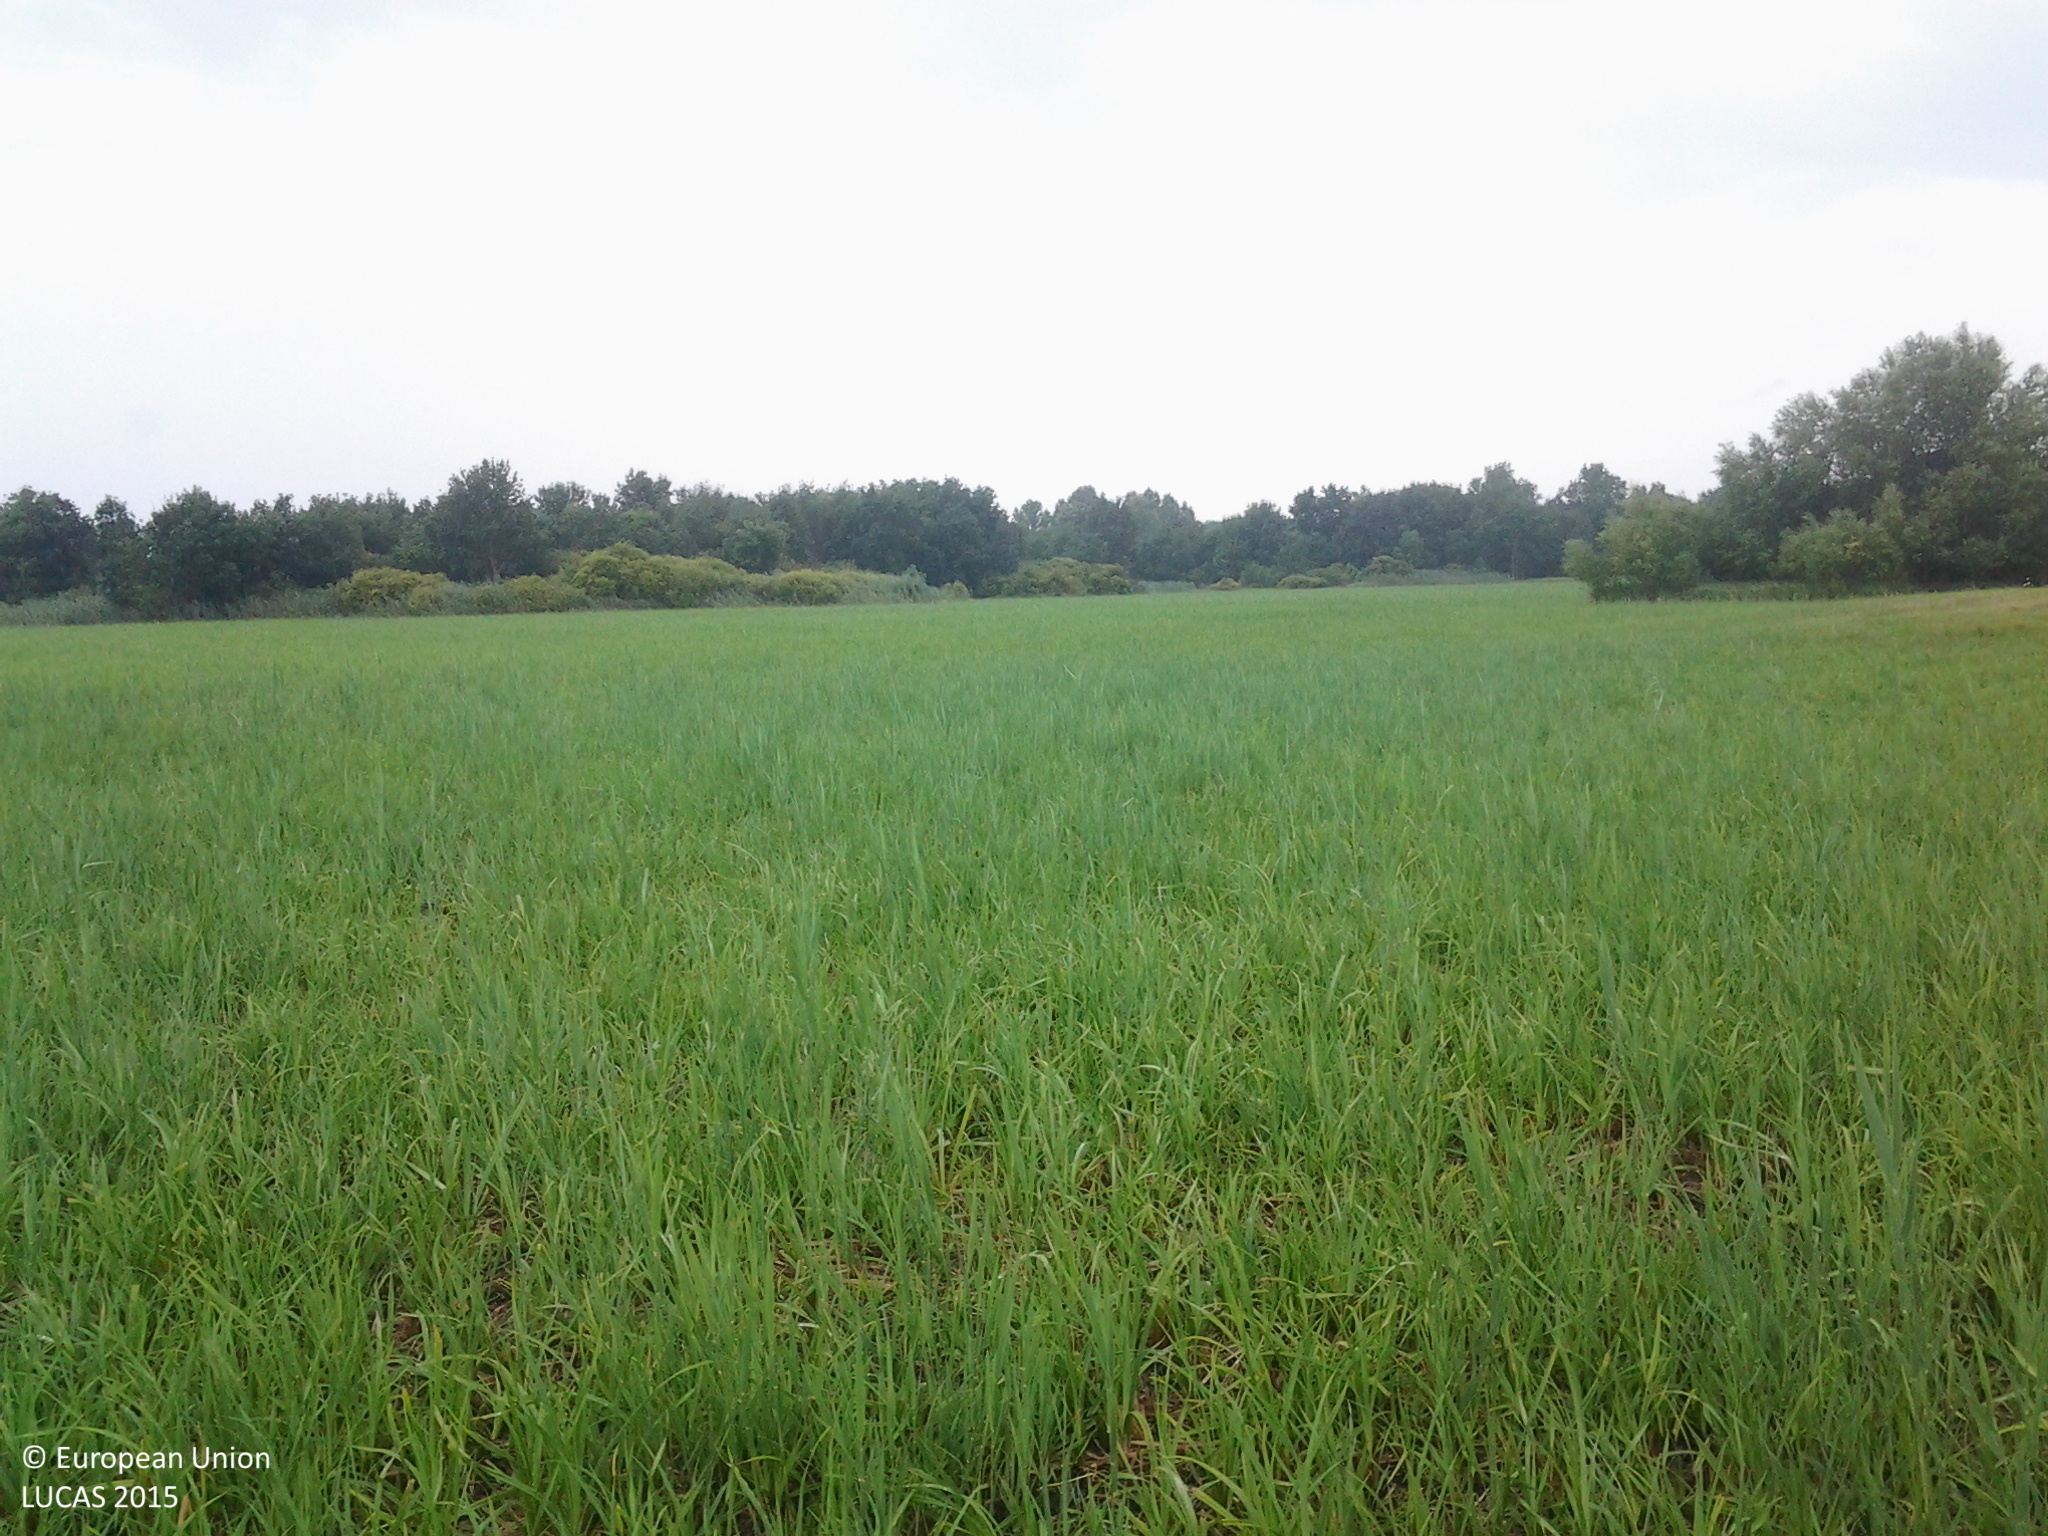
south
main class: Grassland
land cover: Grassland without tree/shrub cover
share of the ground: > 75 %
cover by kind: herbaceous plants 100 %
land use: Agriculture (excluding fallow land and kitchen gardens)
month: July
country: HU
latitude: 46.6738
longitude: 19.2581
